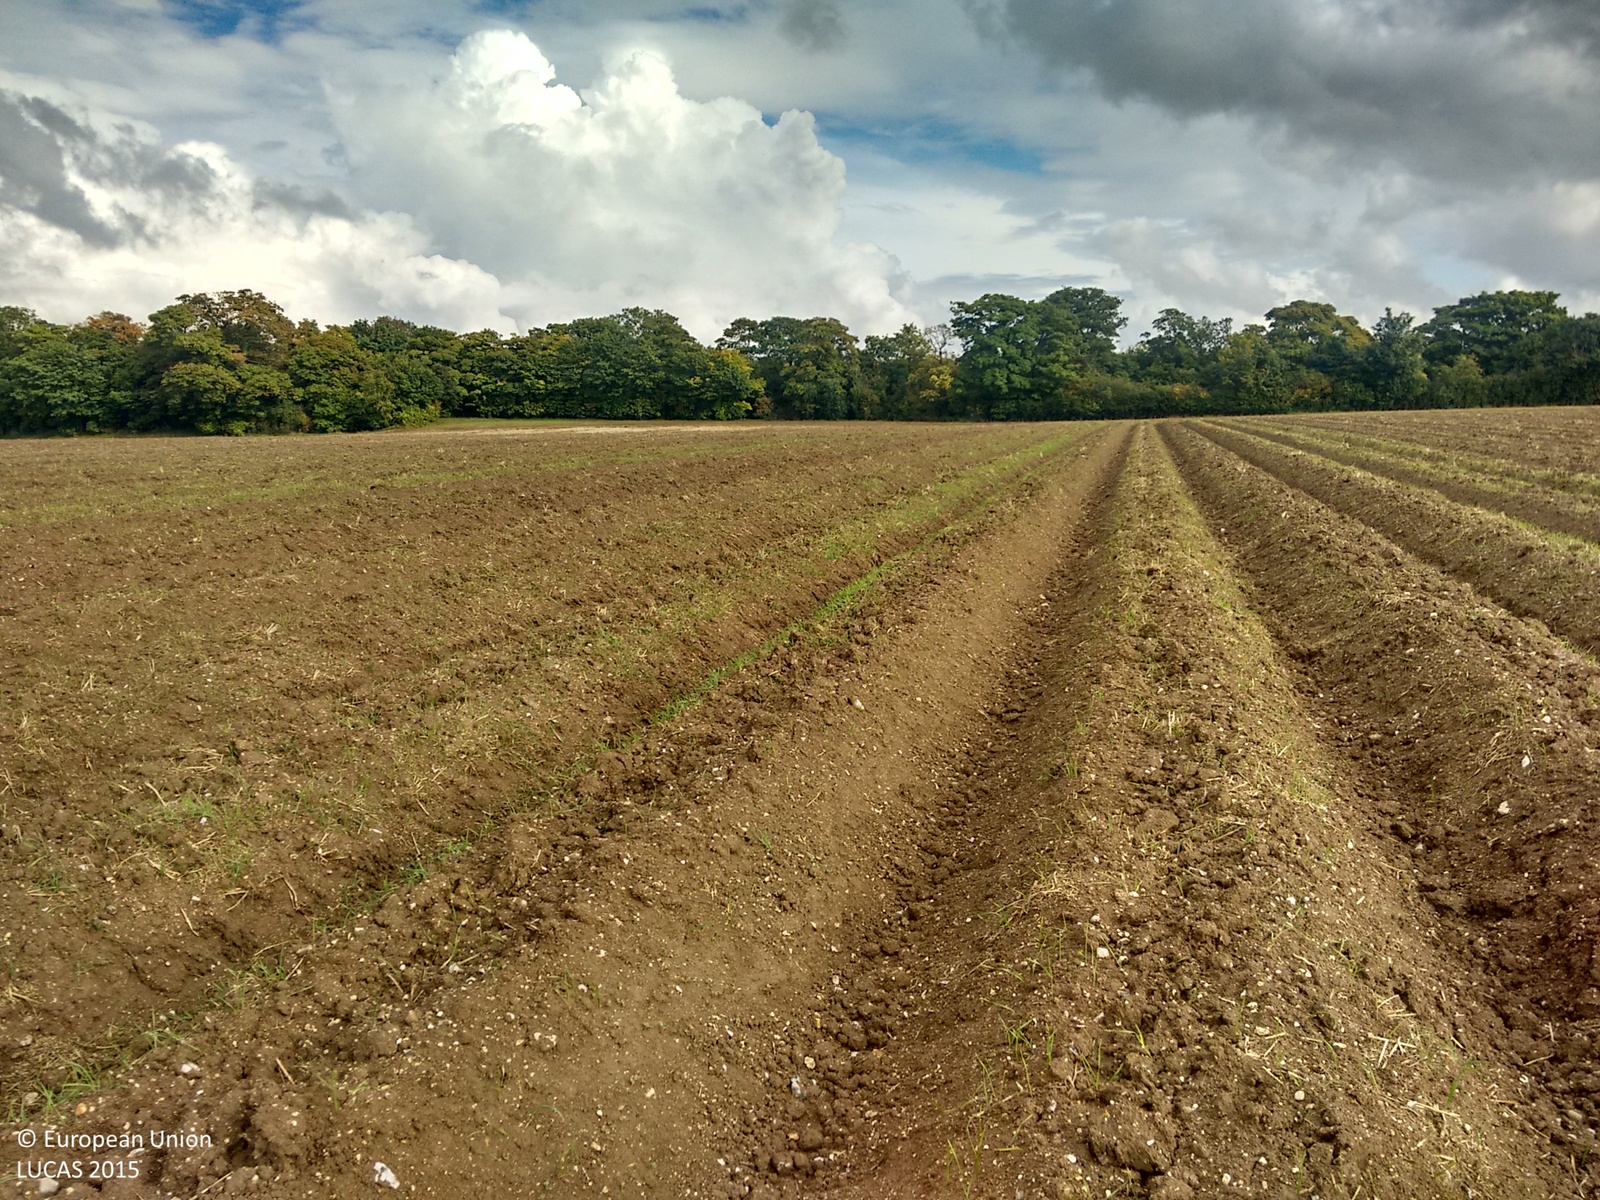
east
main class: Cropland
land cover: Potatoes
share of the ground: < 10 %
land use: Agriculture (excluding fallow land and kitchen gardens)
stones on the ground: < 10 %
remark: Harvested field
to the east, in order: Potatoes; Grassland without tree/shrub cover; Broadleaved woodland; Grass margins; Paved roads, cycling and walking lanes; Grass margins; Other mixed woodland; Grass margins; Arable land (only in case pi)
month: October
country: GB
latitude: 52.0981
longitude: 0.2034
